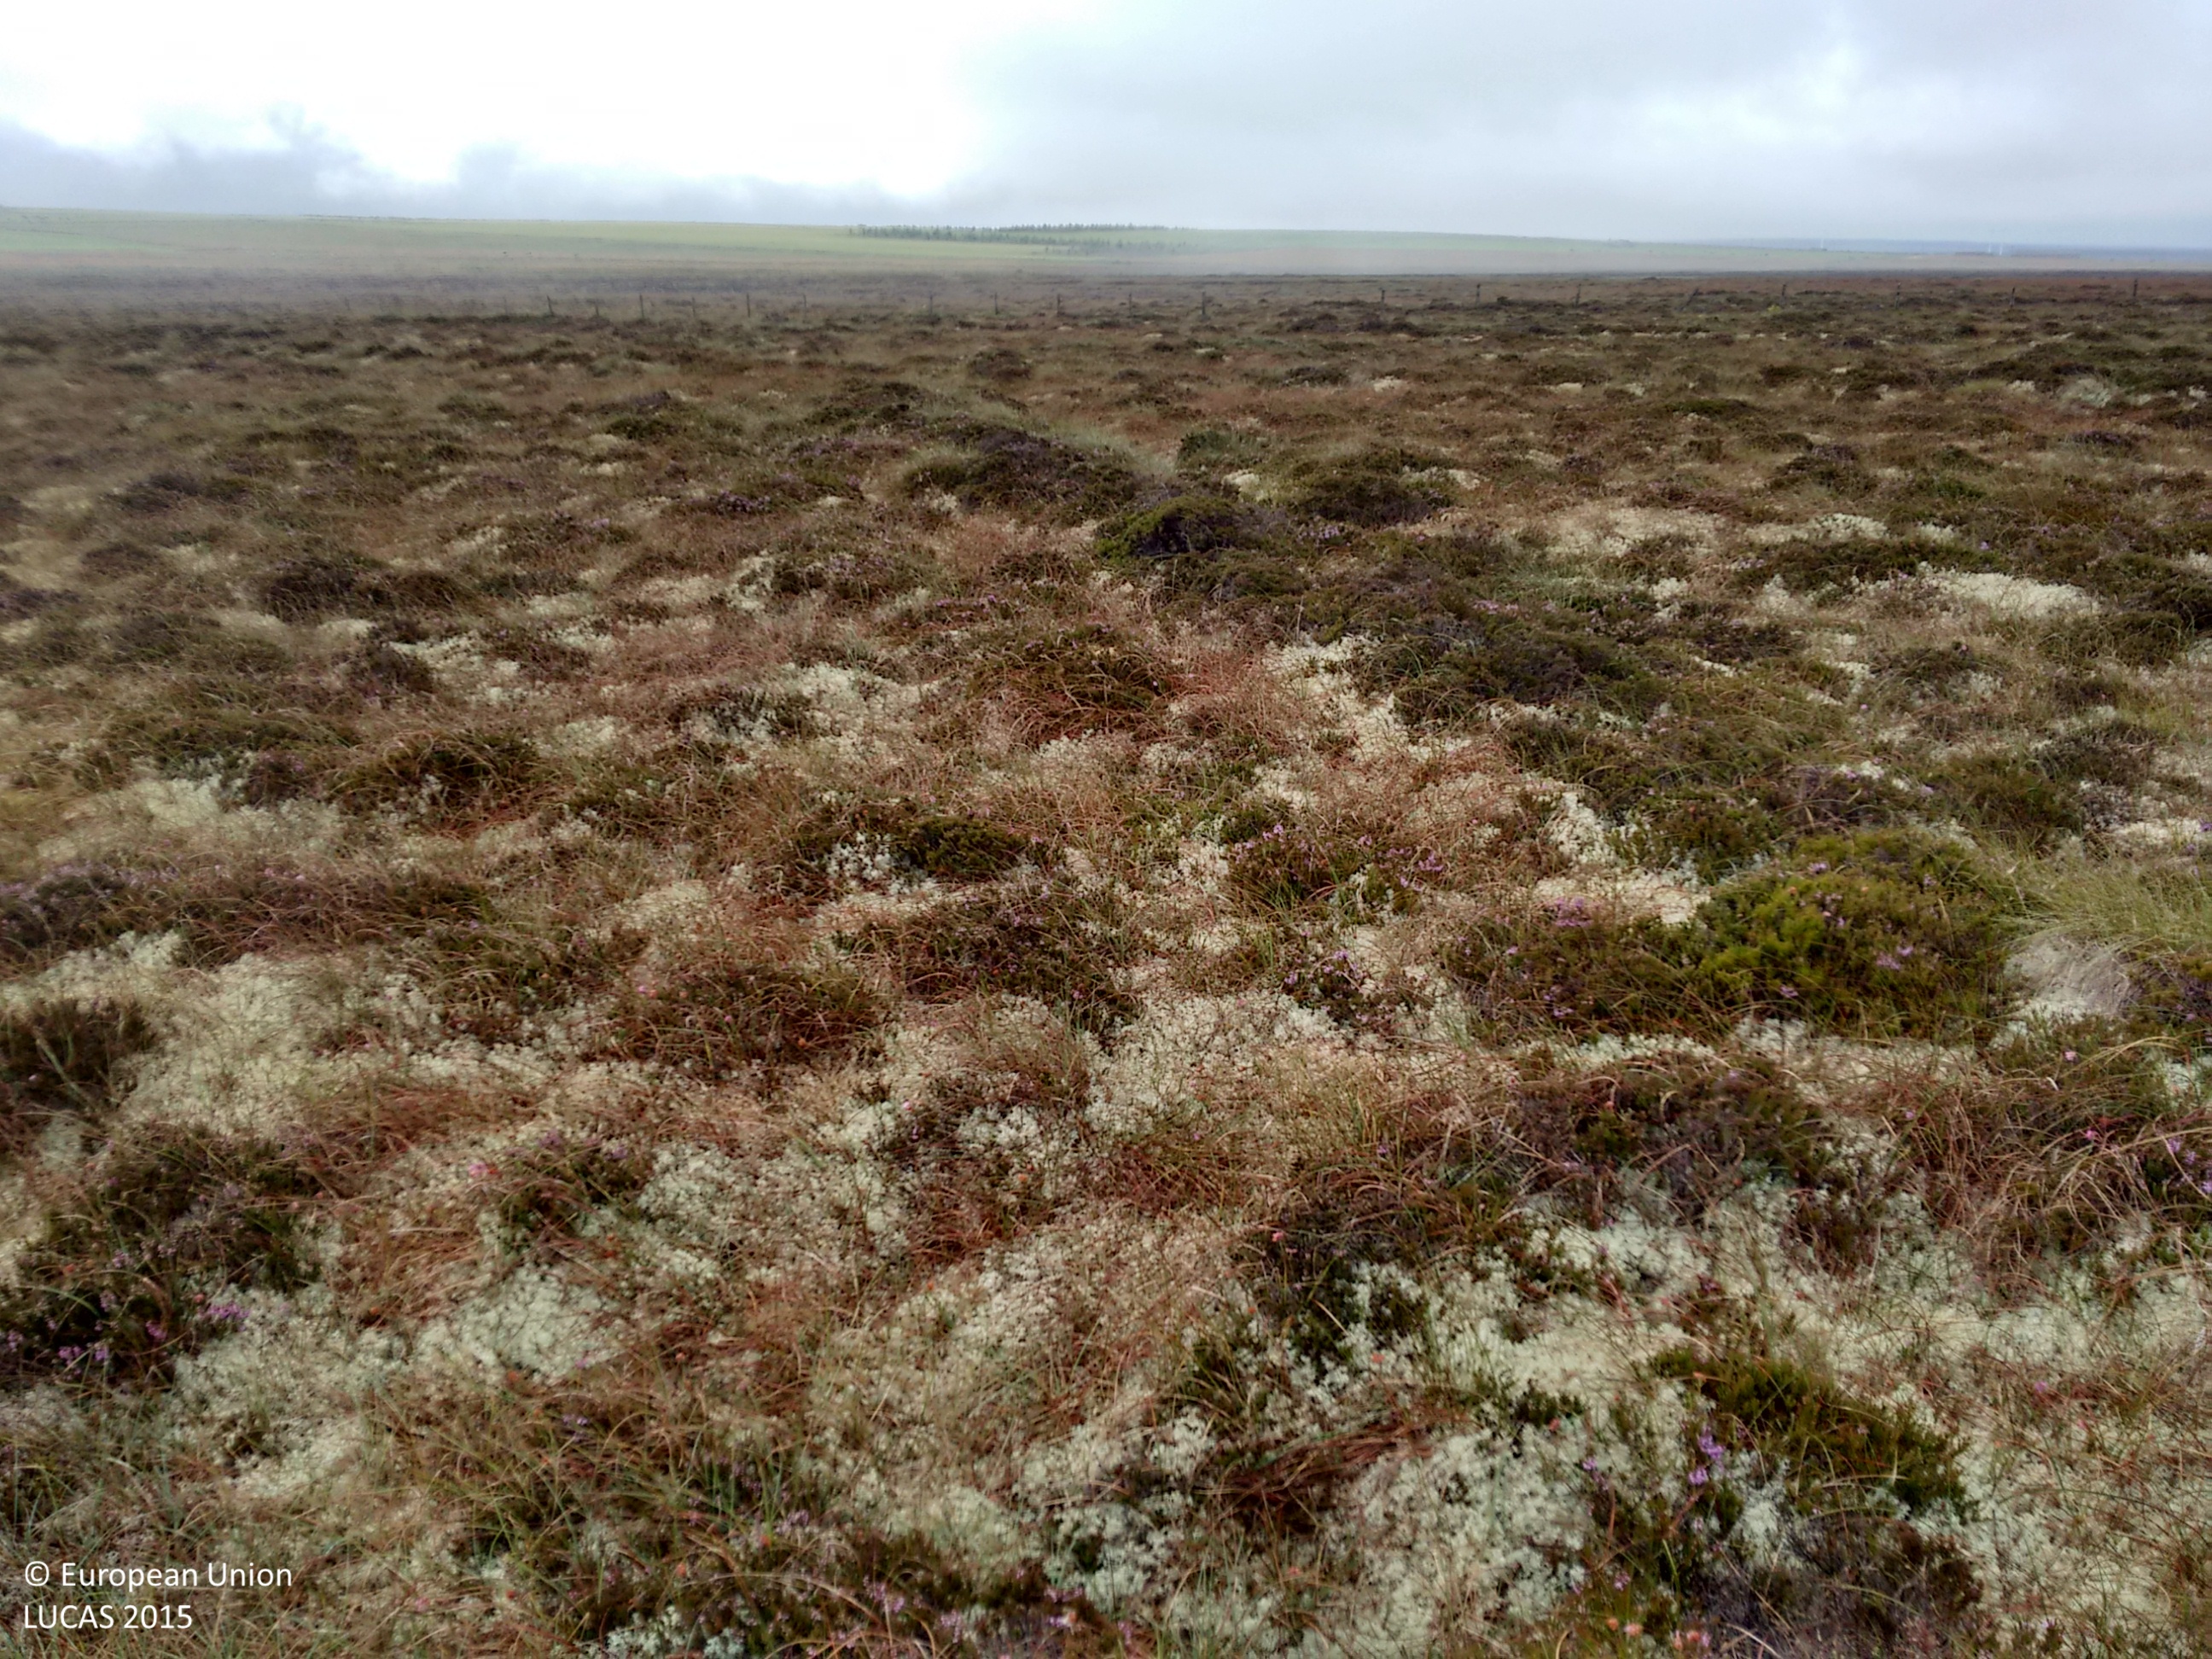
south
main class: Shrubland
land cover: Shrubland without tree cover
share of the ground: 50 - 75 %
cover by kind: shrubs 60 %, lichens and mosses 30 %, herbaceous plants 10 %
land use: Semi-natural and natural areas not in use
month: August
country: GB
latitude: 58.4802
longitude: -3.1783
